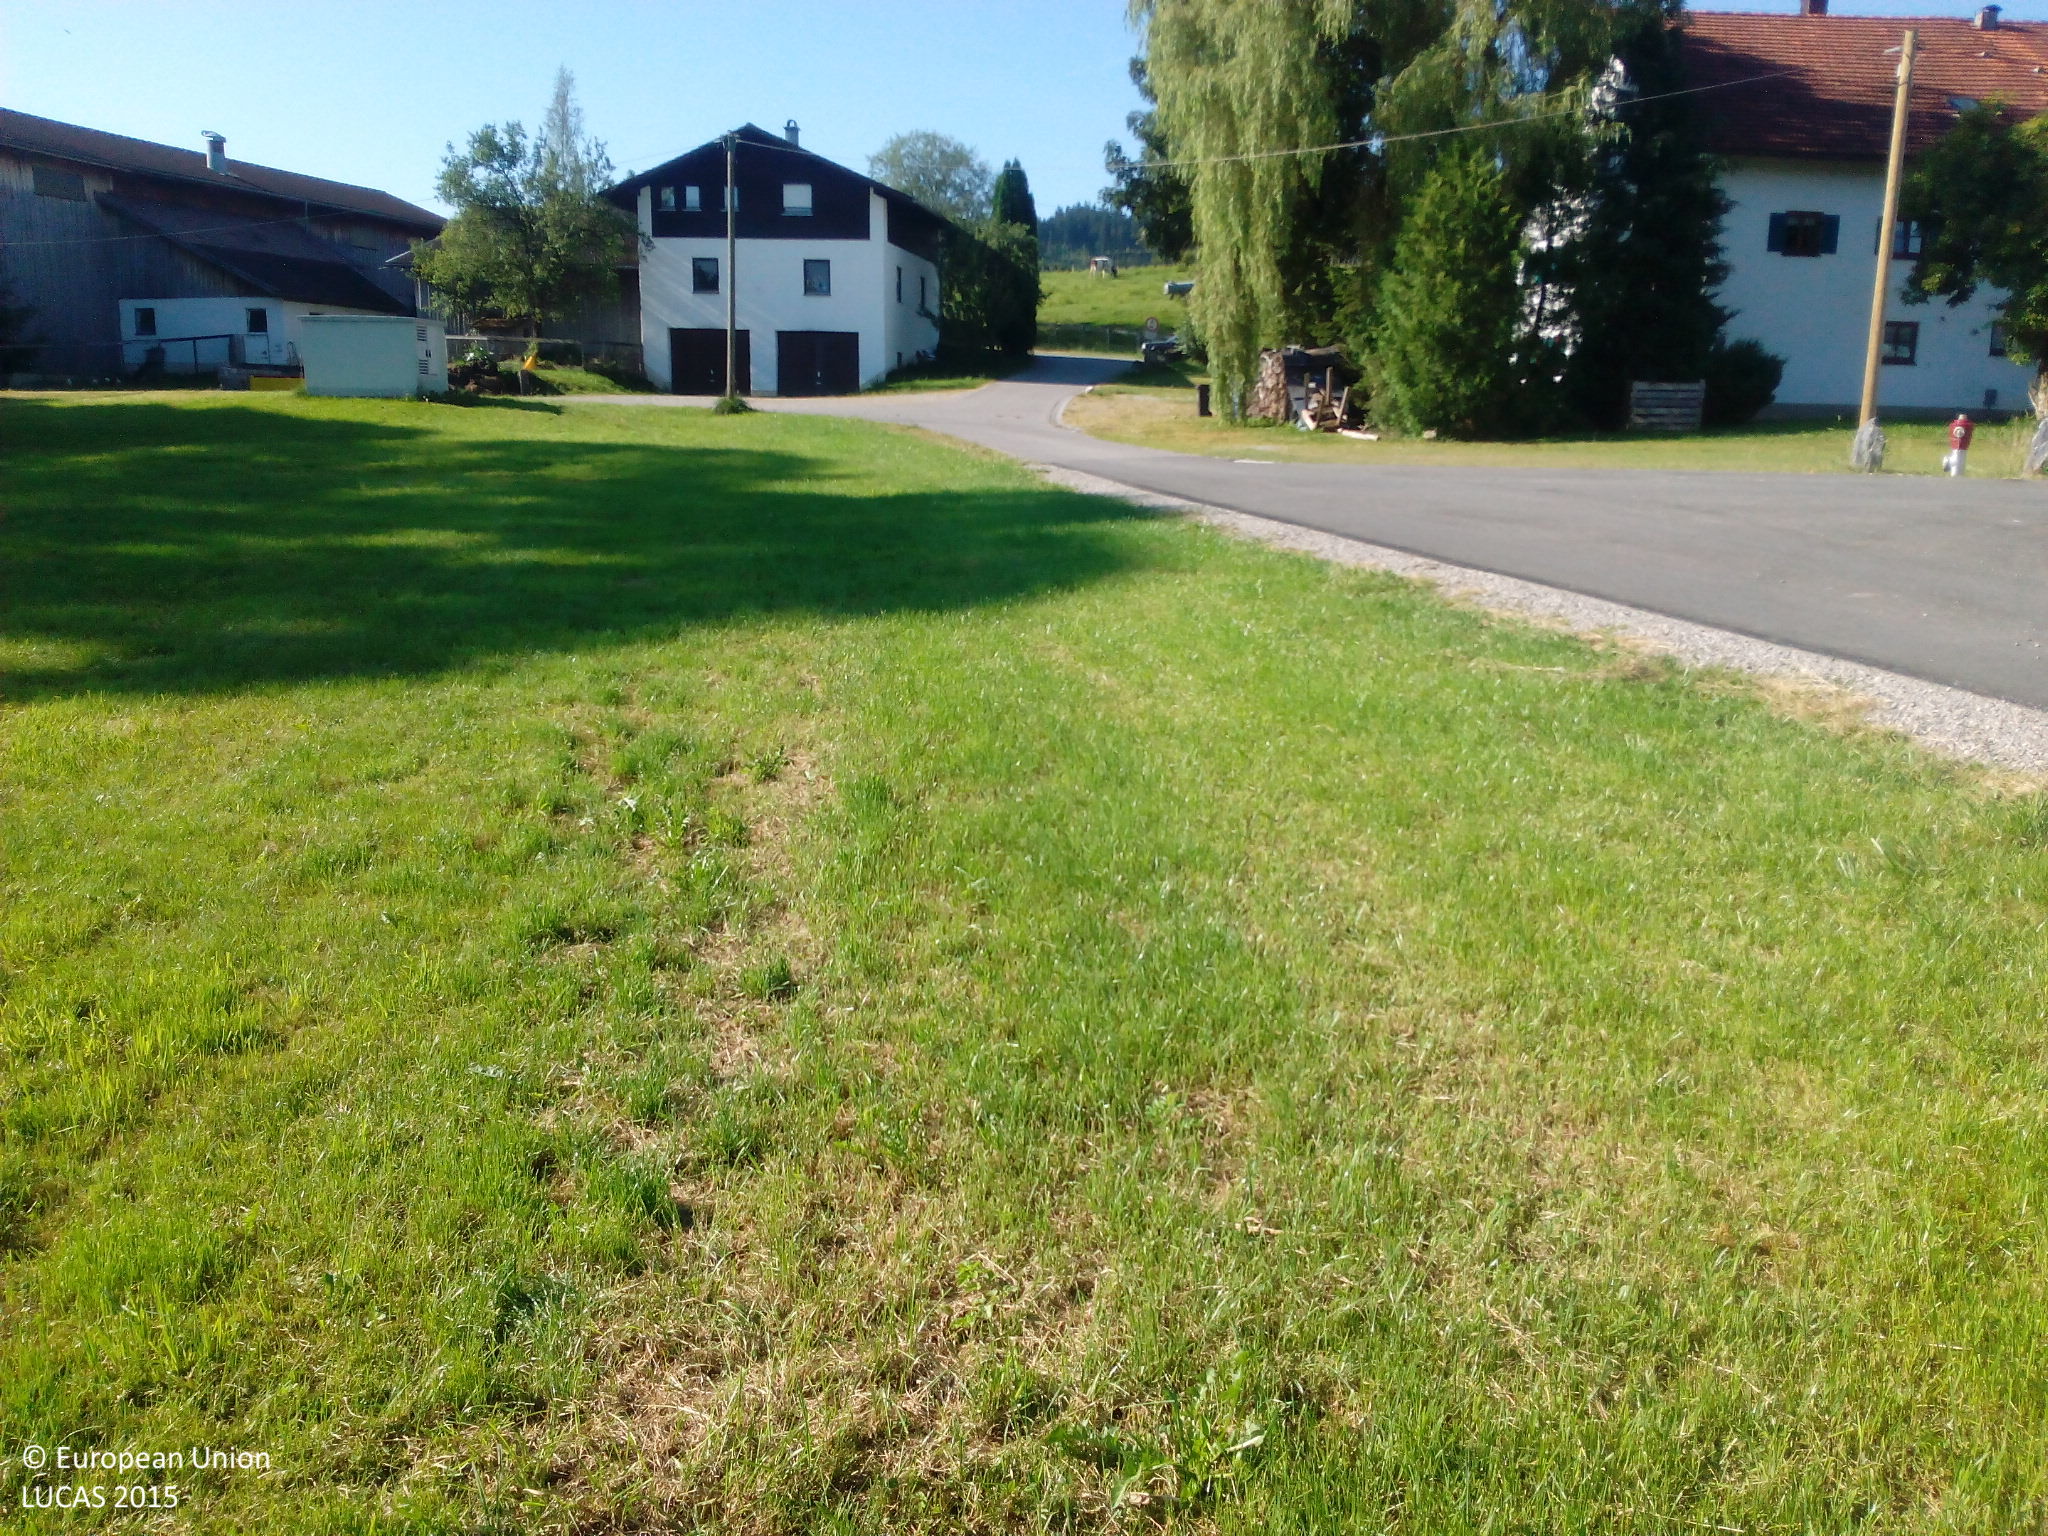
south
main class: Grassland
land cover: Grassland without tree/shrub cover
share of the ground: > 75 %
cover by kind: herbaceous plants 100 %
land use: Agriculture (excluding fallow land and kitchen gardens)
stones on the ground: < 10 %
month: July
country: DE
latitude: 47.6280
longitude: 10.5983
